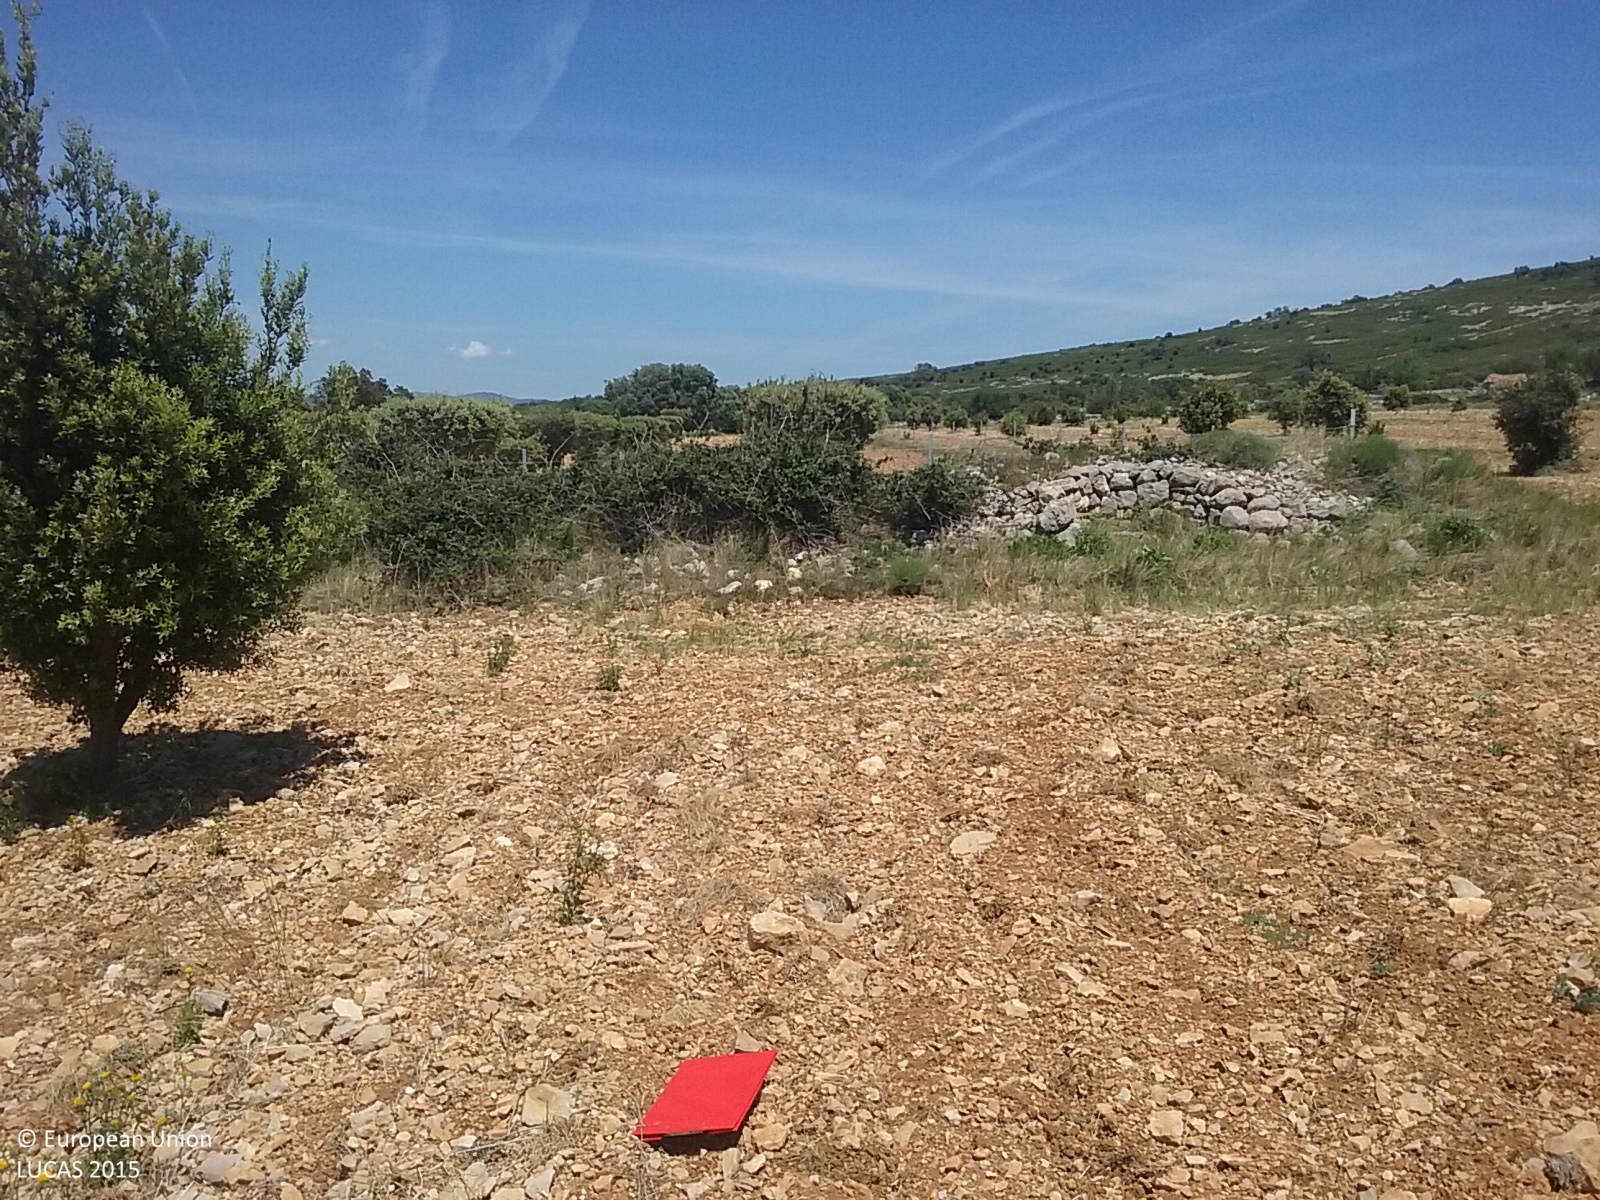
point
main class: Woodland
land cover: Broadleaved woodland
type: broadleaved evergreen forest
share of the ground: 10 - 25 %
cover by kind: unconsolidated bare surface 85 %, broadleaved forest trees 15 %
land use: Forestry
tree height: < 5 m
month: May
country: ES
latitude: 40.4279
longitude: -0.0124
